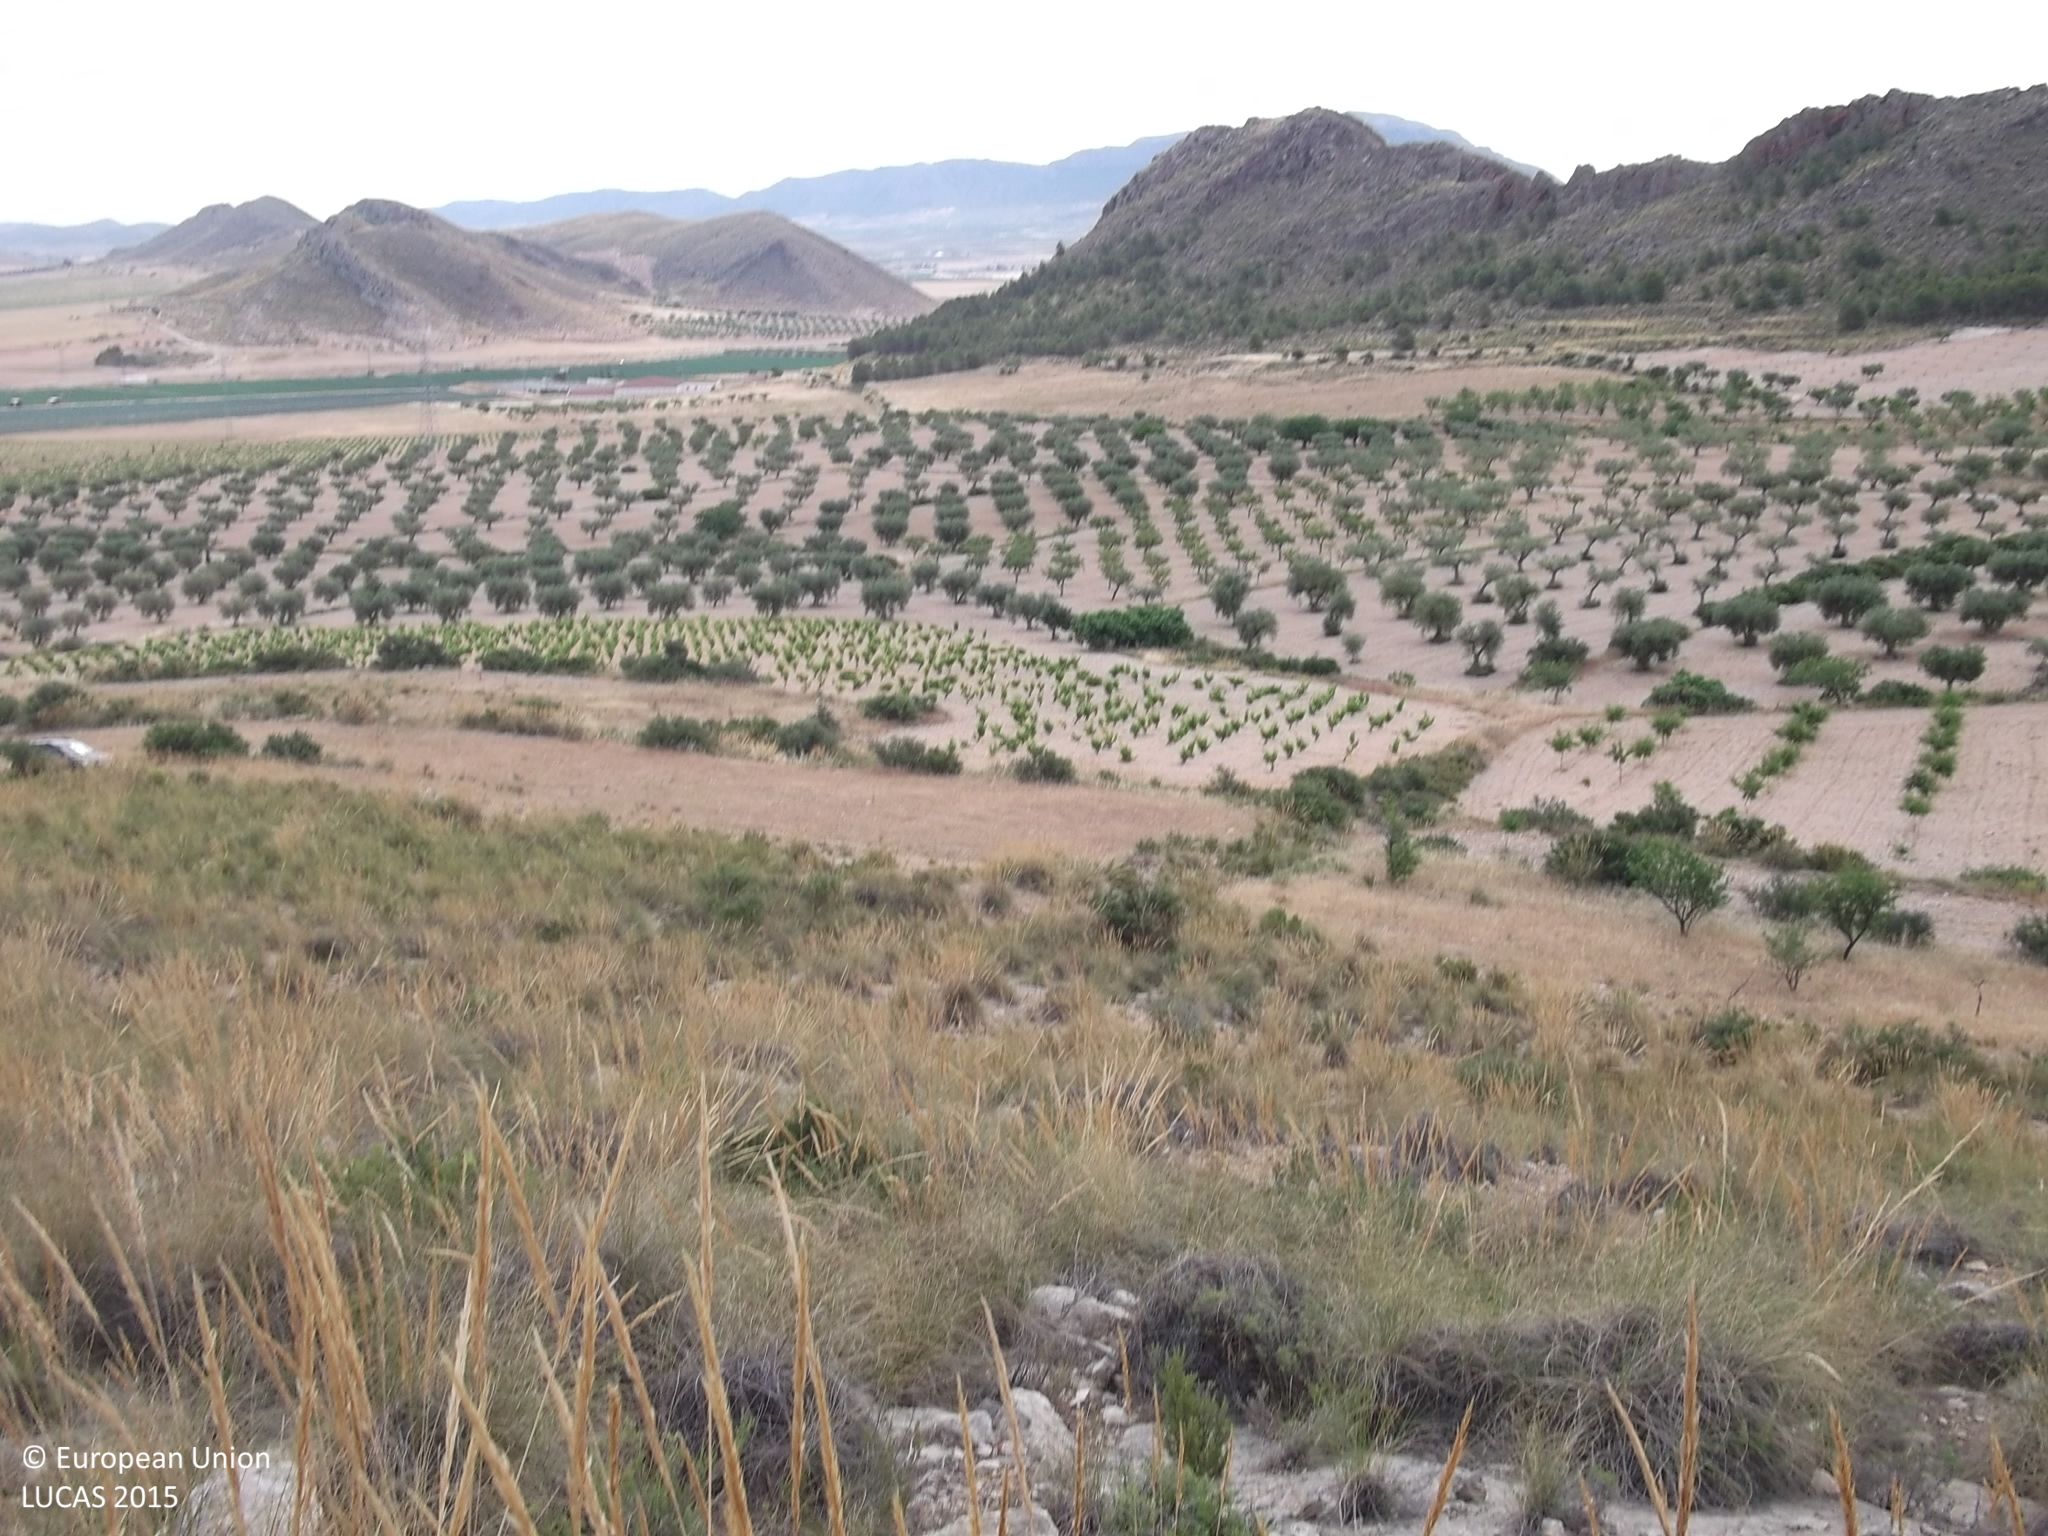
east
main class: Shrubland
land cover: Shrubland without tree cover
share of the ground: 25 - 50 %
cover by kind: consolidated bare surface 40 %, shrubs 30 %, herbaceous plants 30 %
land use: Semi-natural and natural areas not in use
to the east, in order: Shrubland without tree cover; Spontaneously vegetated surfaces; Shrubland without tree cover; Vineyards; Olive groves; Grass margins; Nuts trees
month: May
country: ES
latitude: 38.5071
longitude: -1.3786
